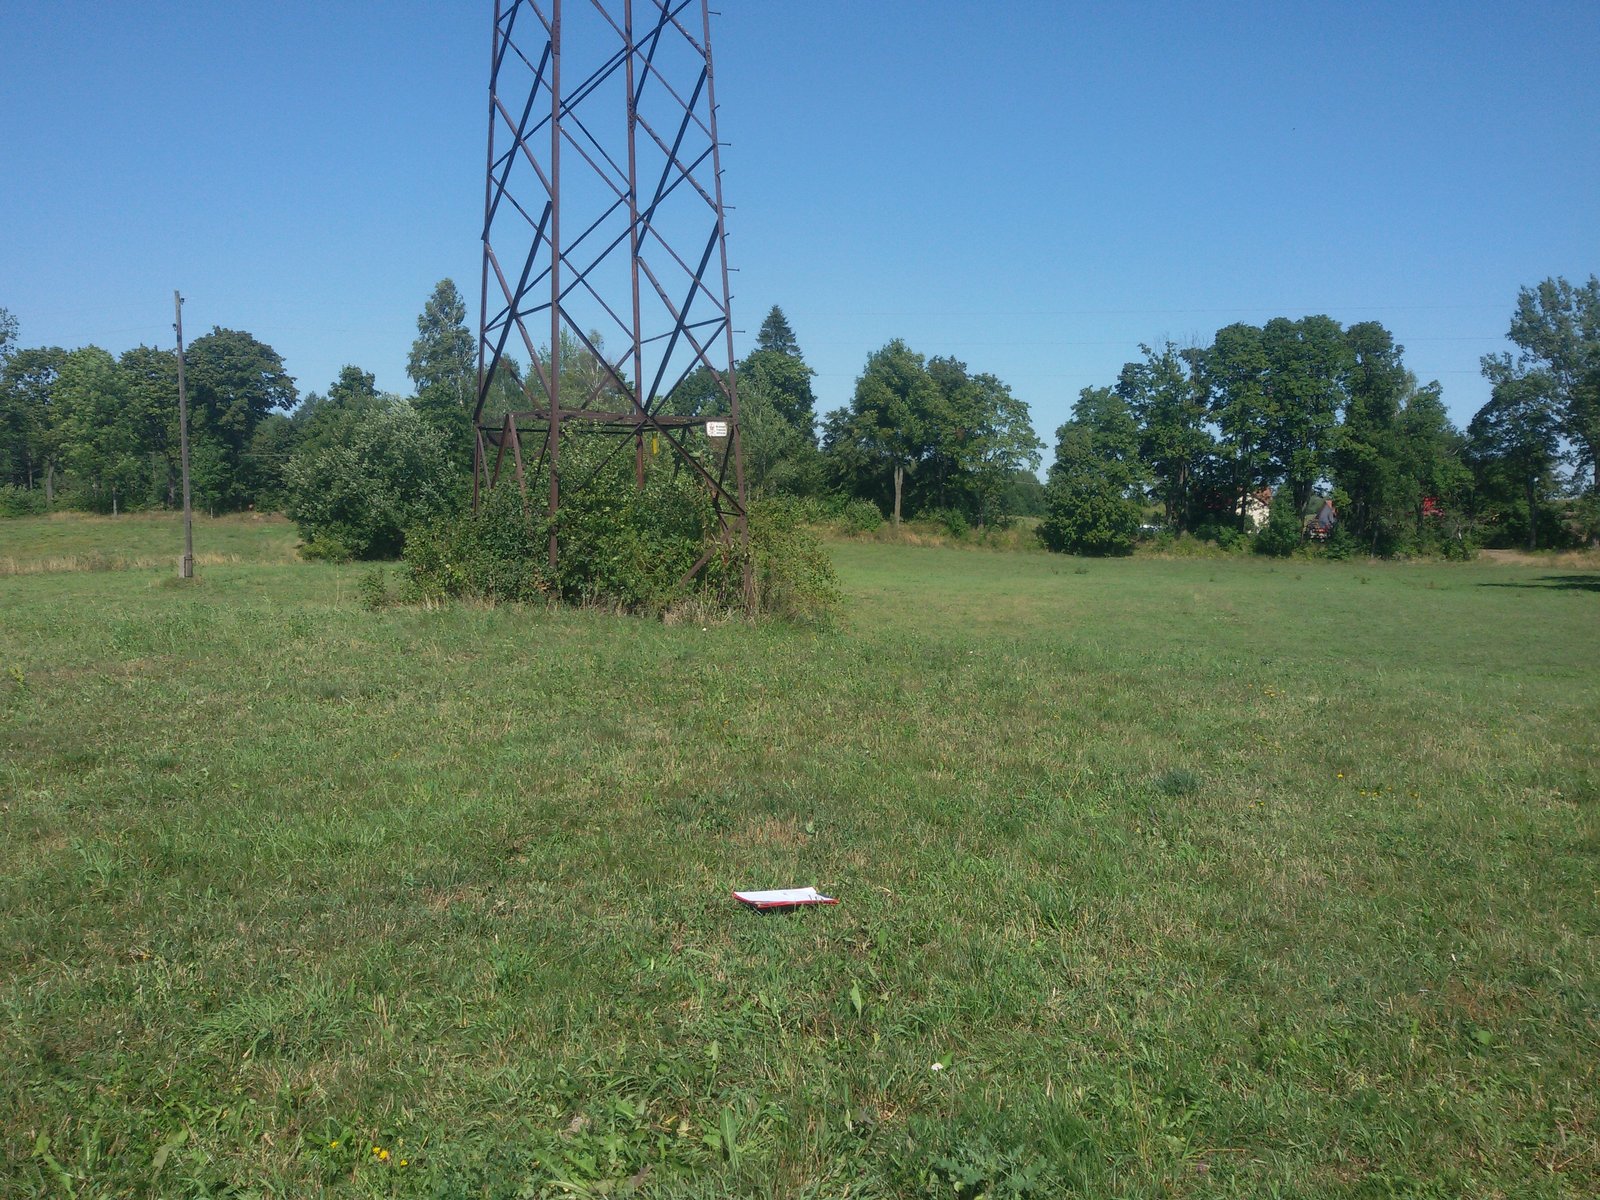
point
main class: Grassland
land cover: Grassland without tree/shrub cover
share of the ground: > 75 %
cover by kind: herbaceous plants 100 %
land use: Agriculture (excluding fallow land and kitchen gardens)
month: August
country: PL
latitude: 53.9207
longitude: 21.1449
